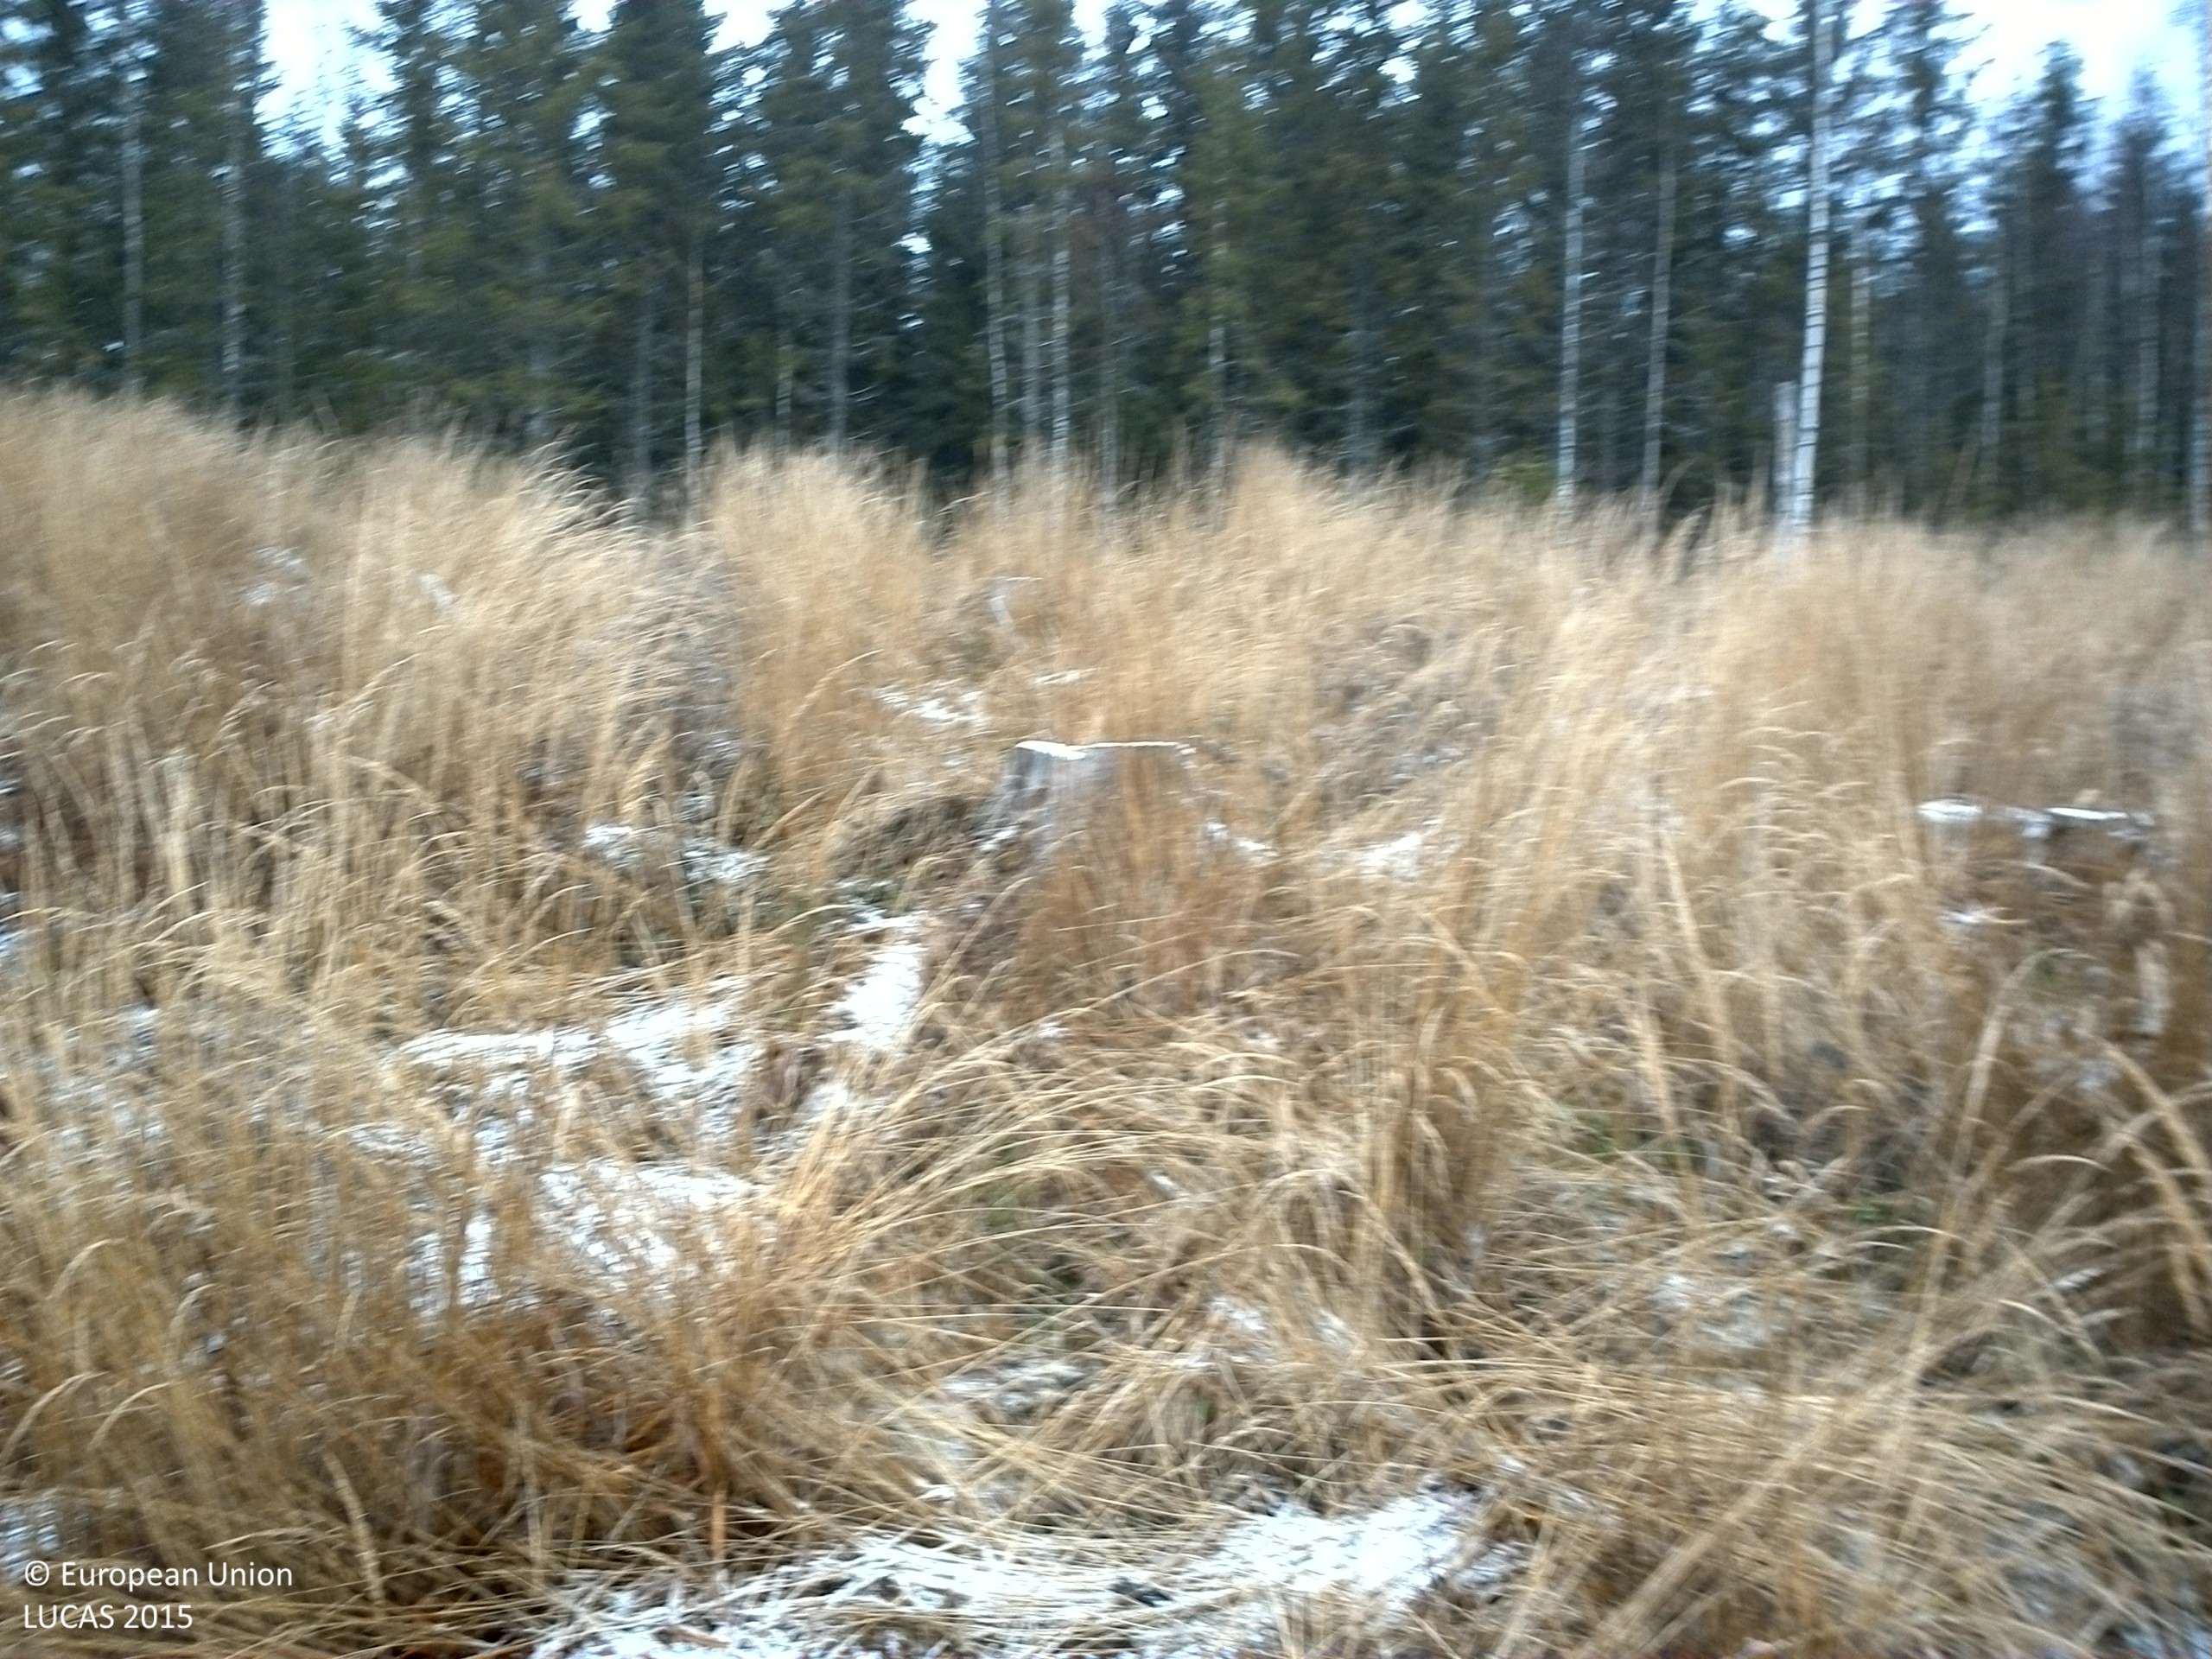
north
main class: Grassland
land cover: Grassland with sparse tree/shrub cover
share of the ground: > 75 %
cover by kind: herbaceous plants 90 %, broadleaved forest trees 5 %, consolidated bare surface 5 %
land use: Forestry
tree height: > 5 m
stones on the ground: < 10 %
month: November
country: SE
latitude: 60.2455
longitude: 16.5469
